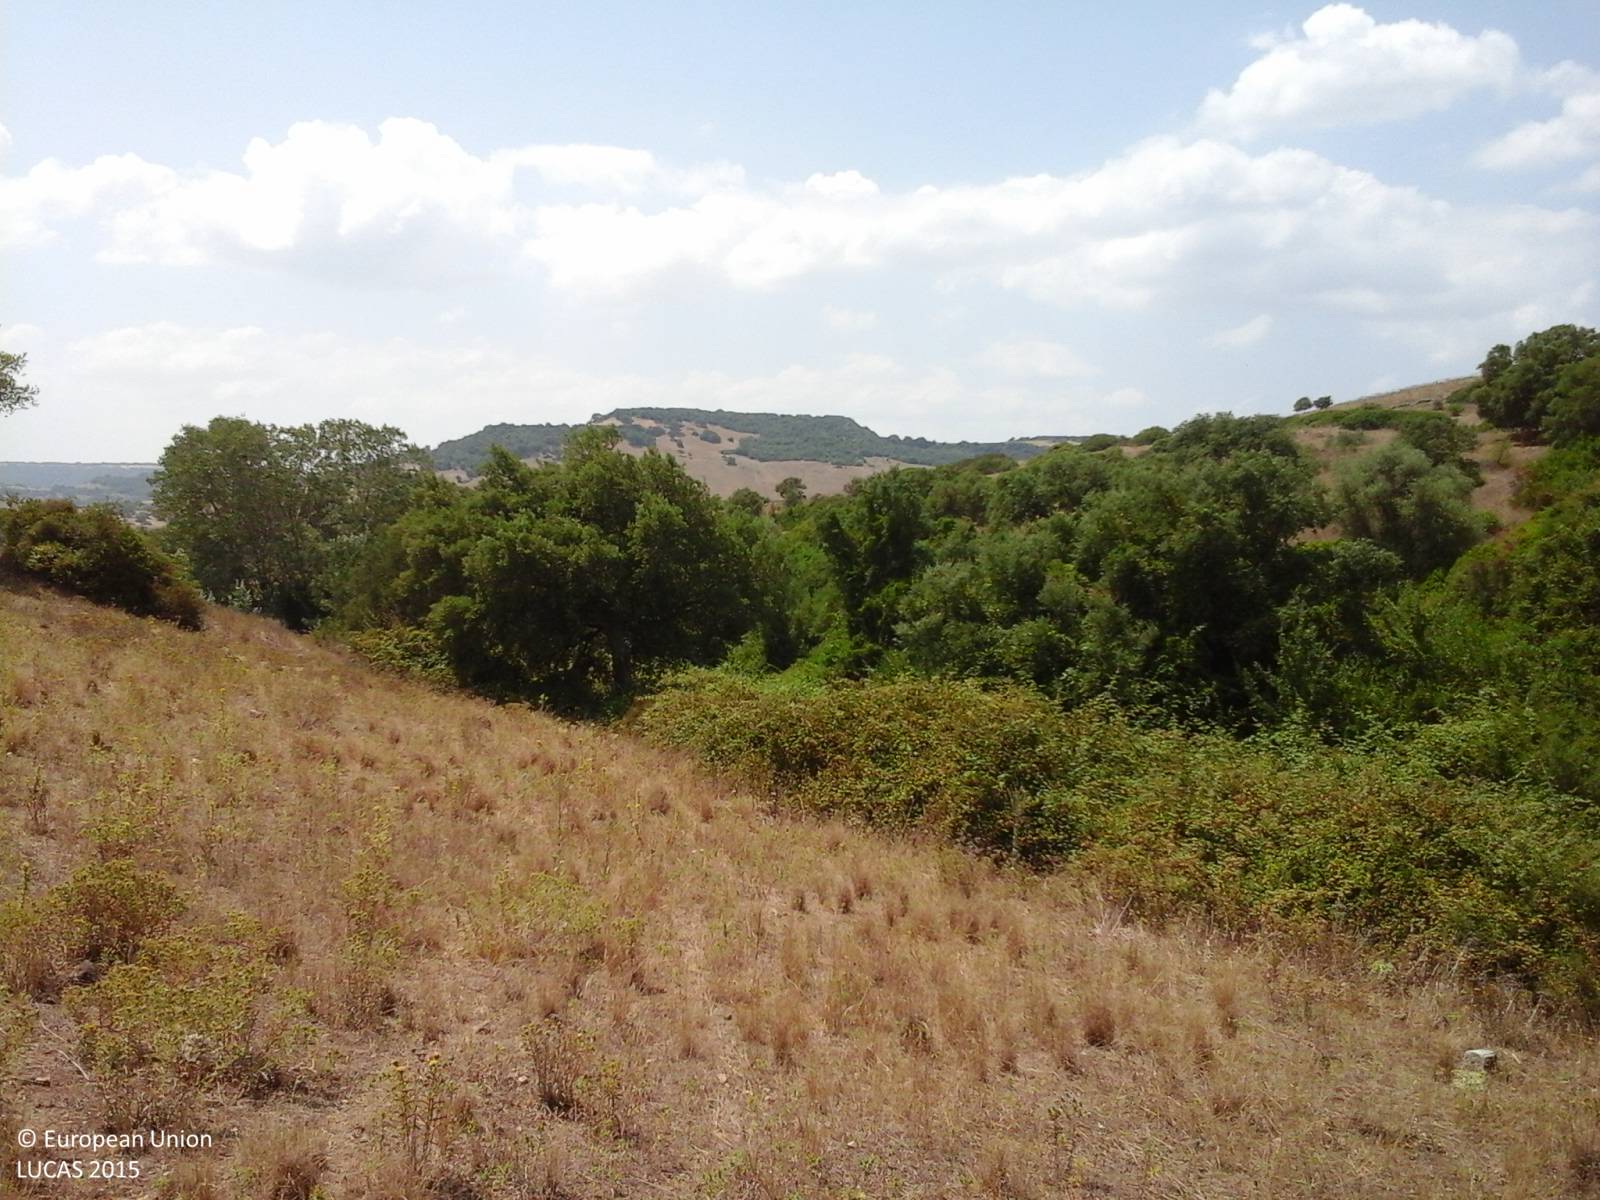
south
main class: Woodland
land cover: Broadleaved woodland
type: thermophilous deciduous forest
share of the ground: 25 - 50 %
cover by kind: broadleaved forest trees 65 %, shrubs 35 %
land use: Forestry
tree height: < 5 m
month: July
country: IT
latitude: 39.9895
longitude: 8.8935
